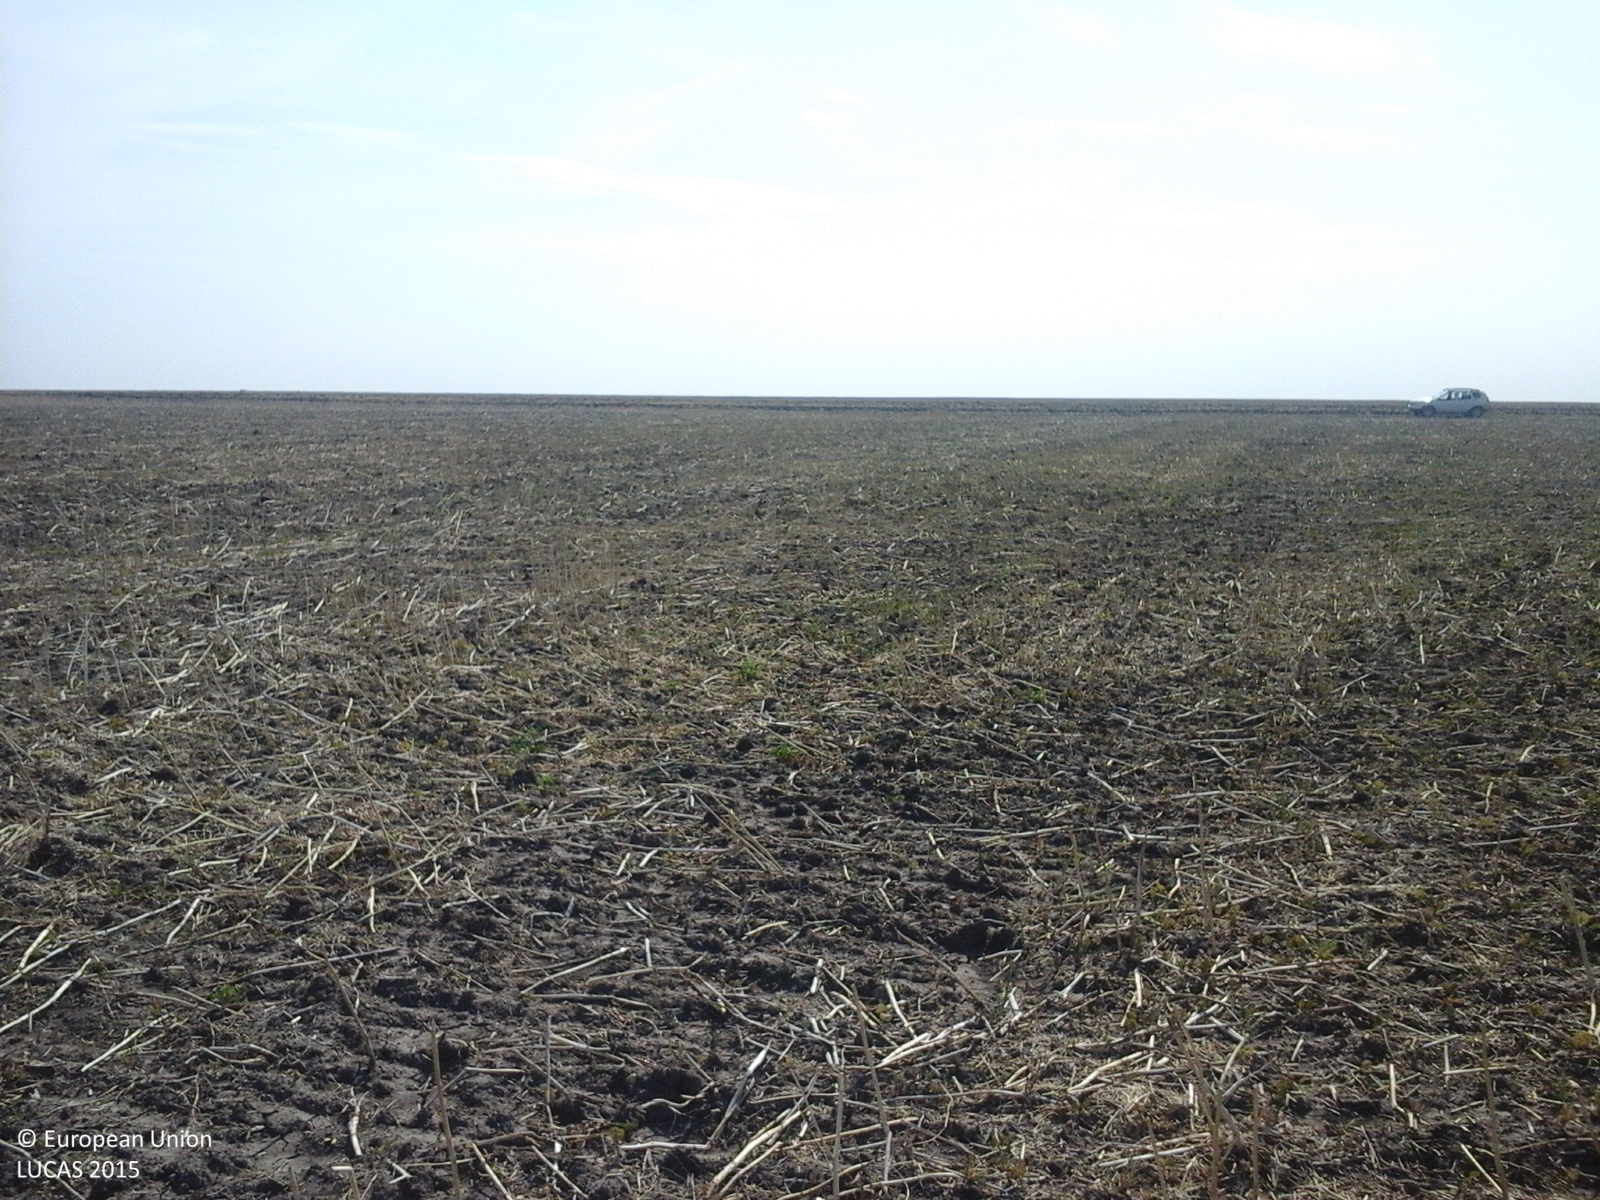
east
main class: Cropland
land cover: Rape and turnip rape
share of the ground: 10 - 25 %
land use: Agriculture (excluding fallow land and kitchen gardens)
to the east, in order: Rape and turnip rape; Grass margins; Tracks; Common wheat
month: August
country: RO
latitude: 44.2308
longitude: 23.0773
